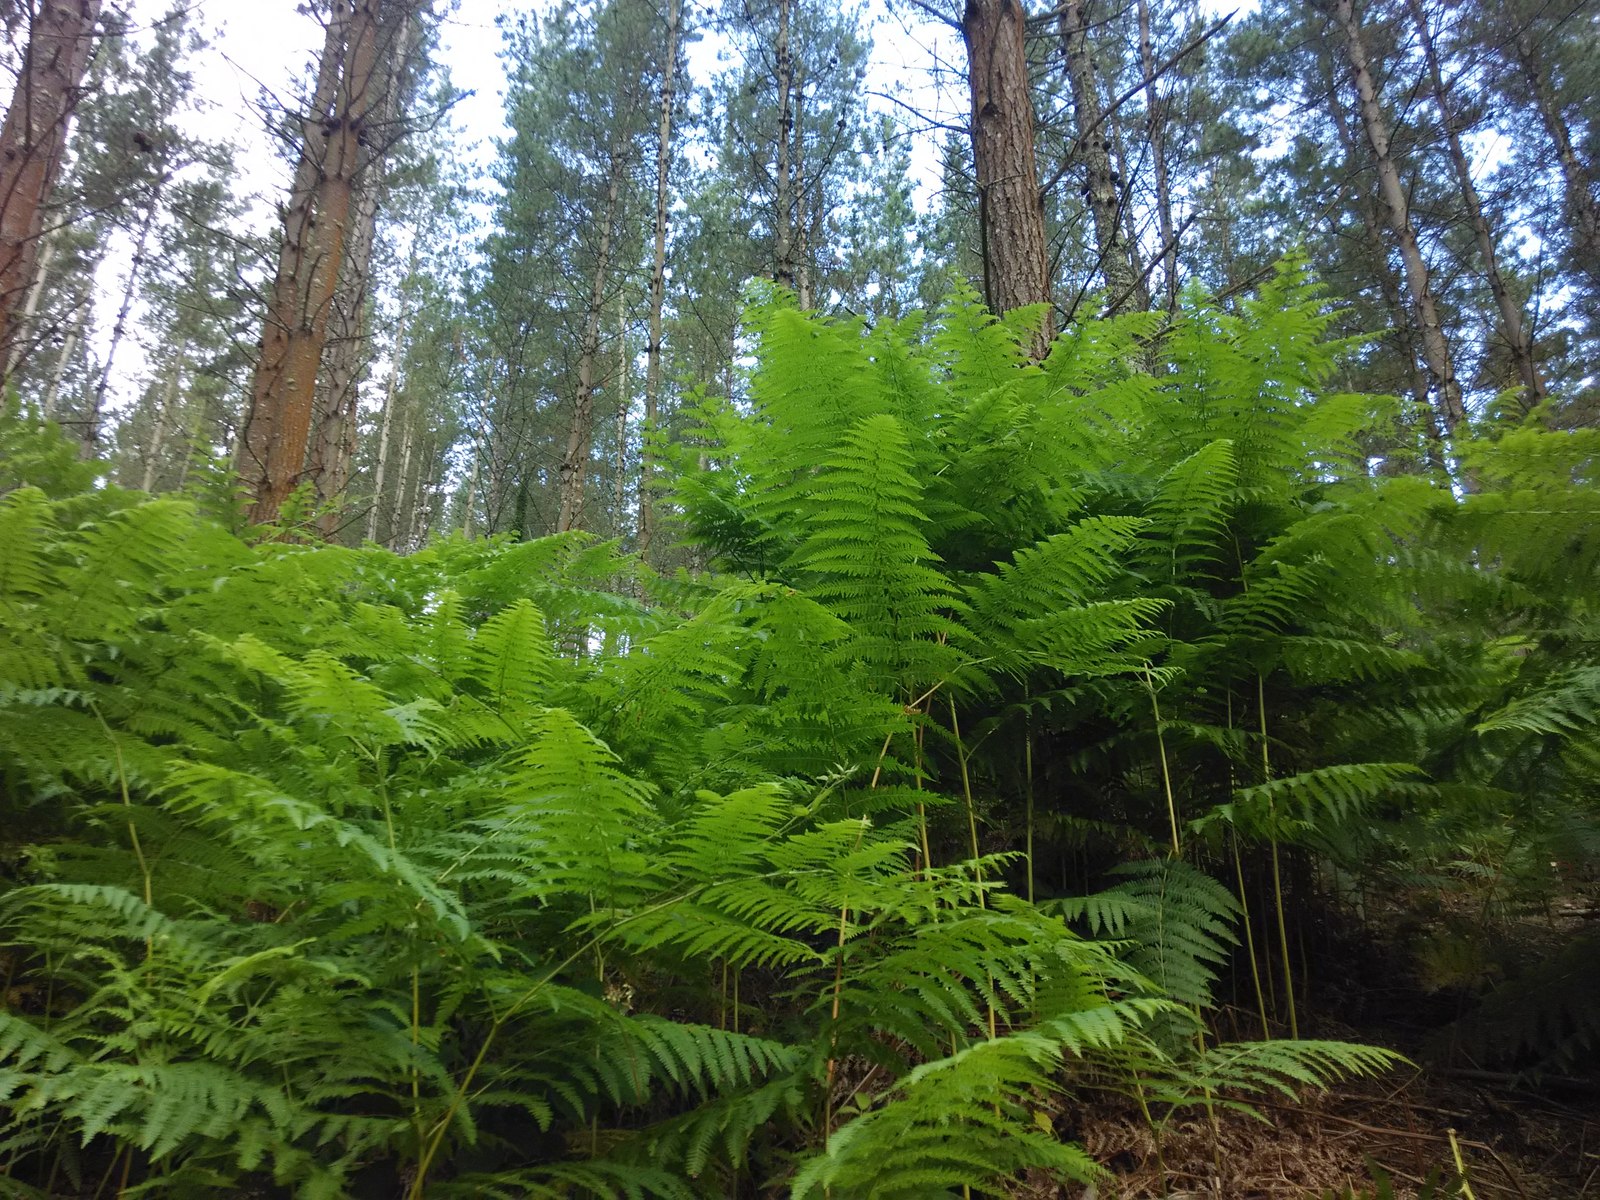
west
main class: Woodland
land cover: Pine dominated coniferous woodland
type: exotic forest
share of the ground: > 75 %
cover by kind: coniferous forest trees 100 %
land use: Forestry
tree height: > 5 m
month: June
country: ES
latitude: 43.3185
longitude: -2.4950
